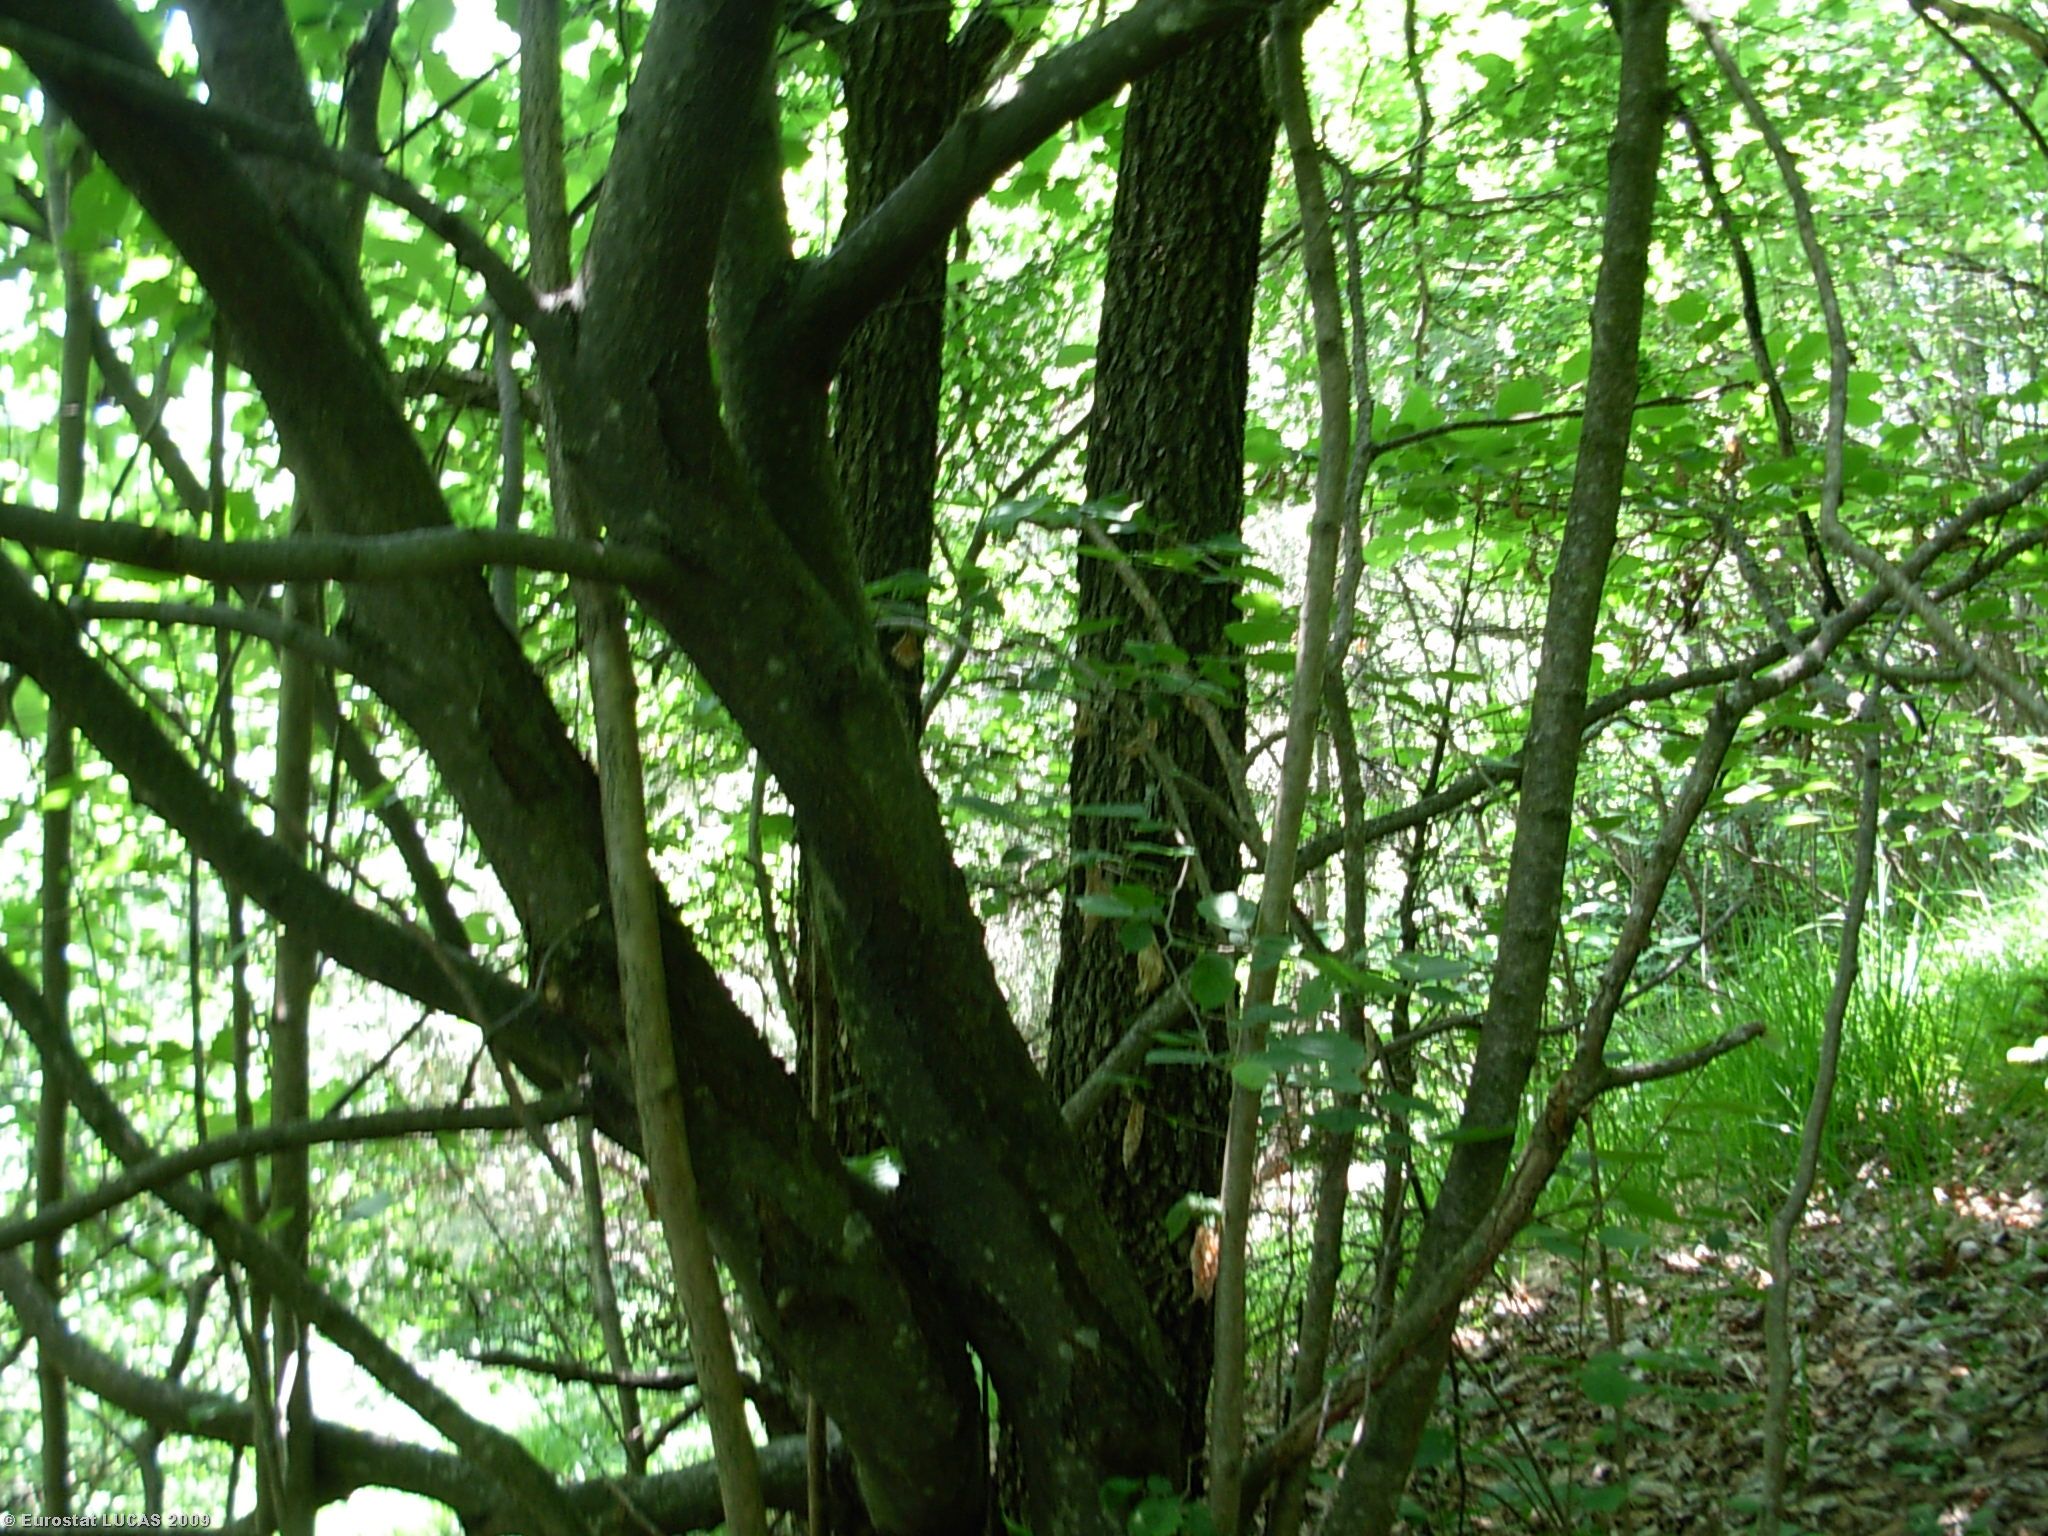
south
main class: Woodland
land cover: Broadleaved woodland
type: mountainous beech forest
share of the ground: > 75 %
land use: Unused
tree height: > 5 m
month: June
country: IT
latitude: 45.7195
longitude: 10.5002
